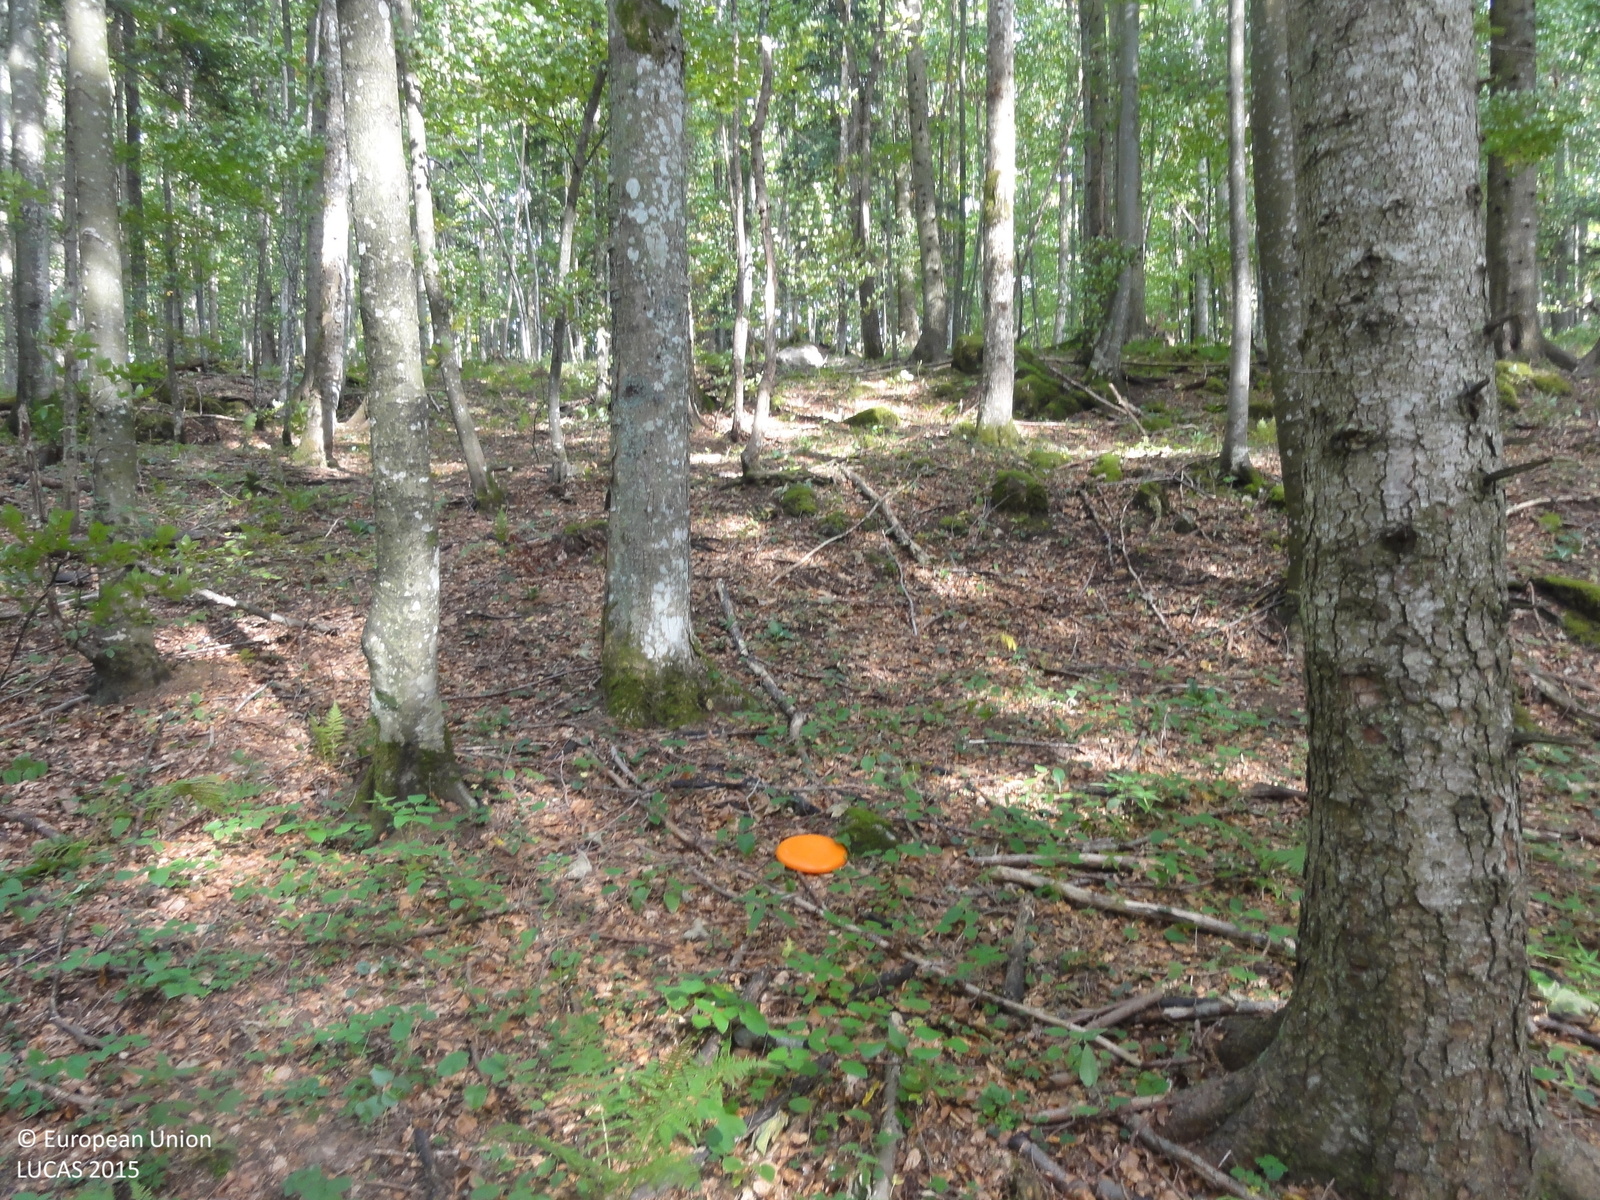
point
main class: Woodland
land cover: Spruce dominated mixed woodland
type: mountainous beech forest
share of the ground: > 75 %
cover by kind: broadleaved forest trees 60 %, coniferous forest trees 40 %
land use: Forestry
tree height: > 5 m
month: September
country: SI
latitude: 45.6165
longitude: 15.0872
